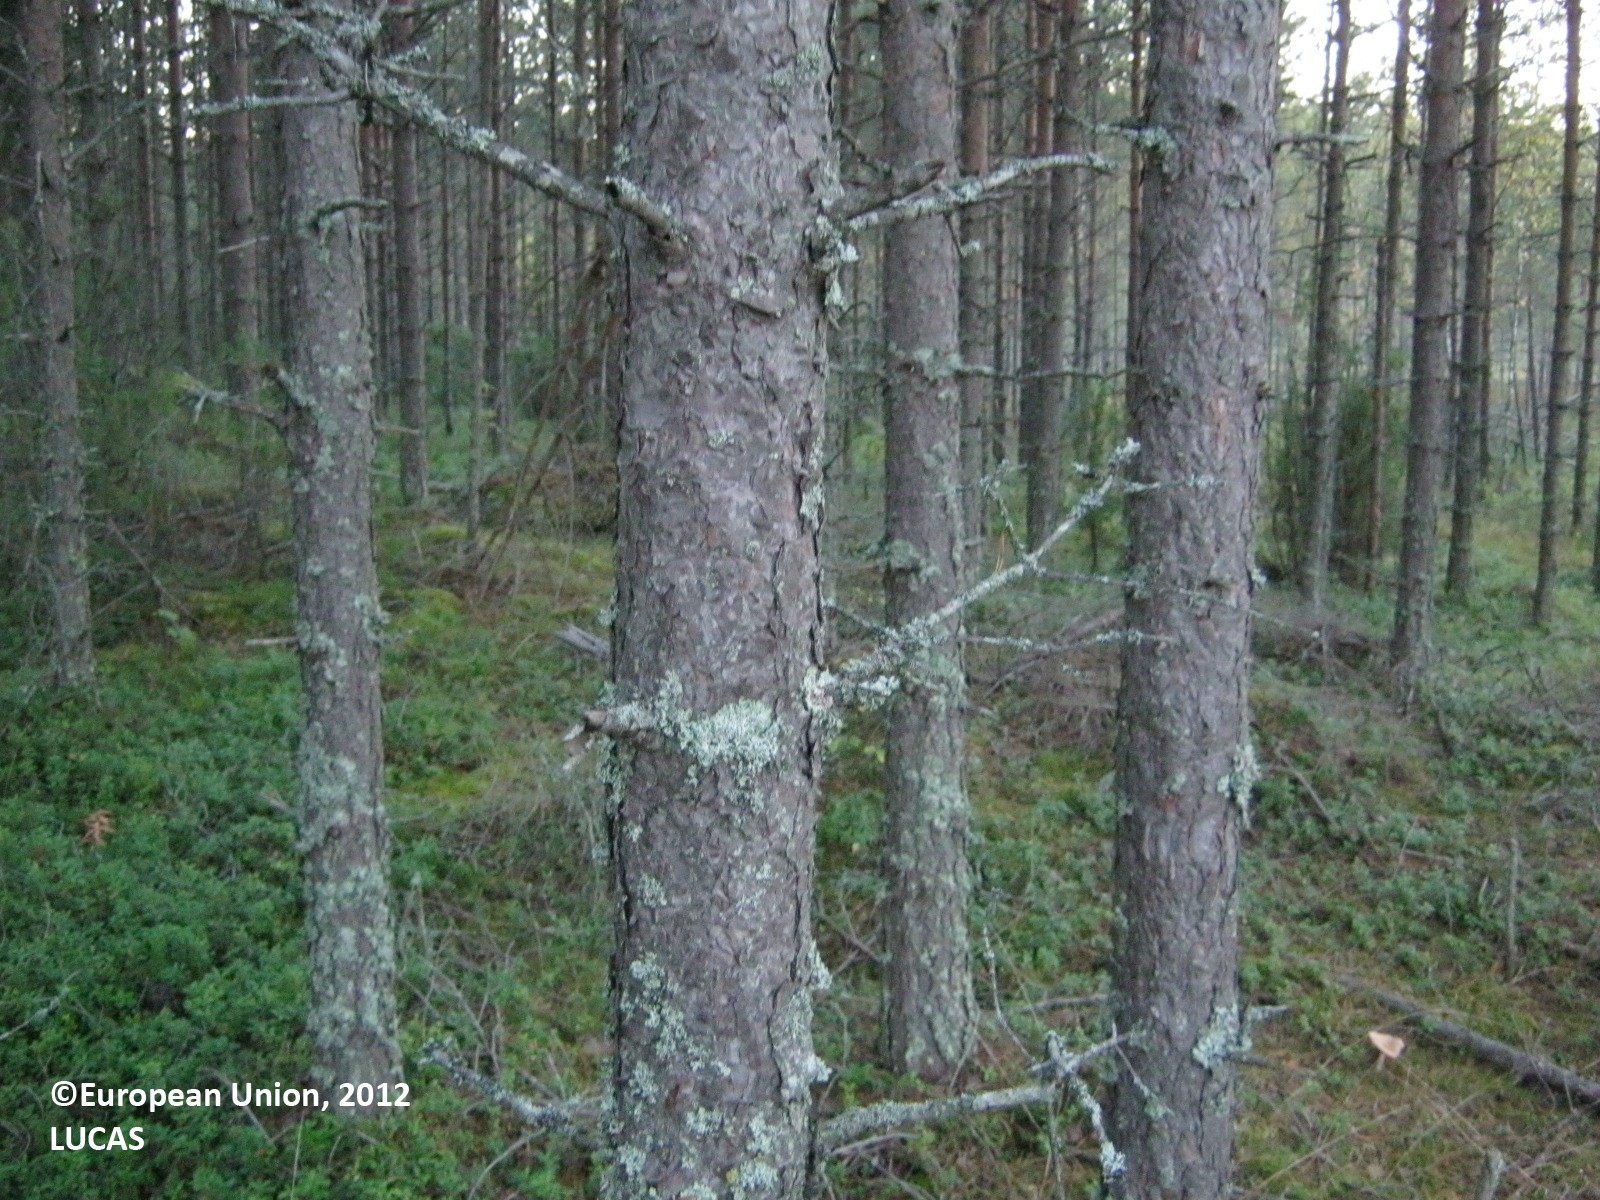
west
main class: Woodland
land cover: Pine dominated coniferous woodland
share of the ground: 50 - 75 %
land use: Forestry
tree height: < 5 m
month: September
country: FI
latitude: 60.8835
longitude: 27.9779
